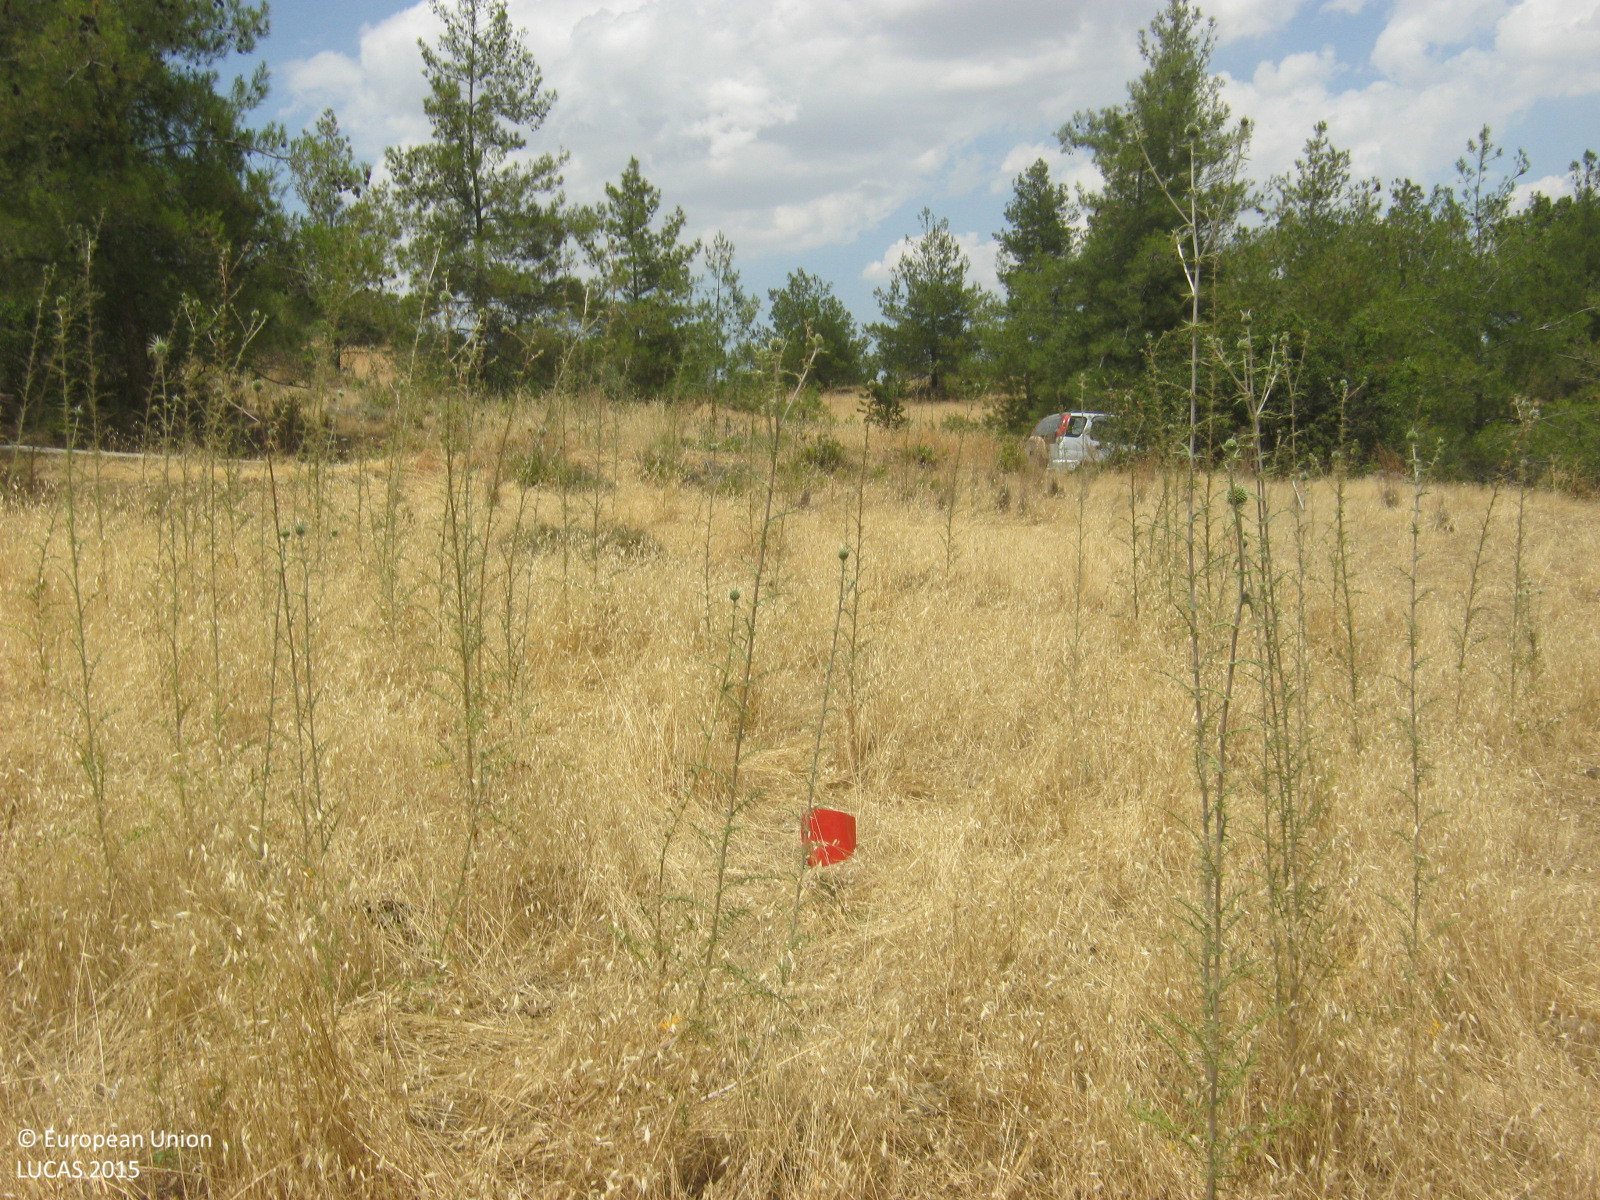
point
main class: Grassland
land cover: Grassland with sparse tree/shrub cover
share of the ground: > 75 %
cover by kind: herbaceous plants 90 %, coniferous forest trees 5 %, shrubs 5 %
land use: Semi-natural and natural areas not in use
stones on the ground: 10 - 25 %
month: June
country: CY
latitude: 34.9871
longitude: 33.1978
